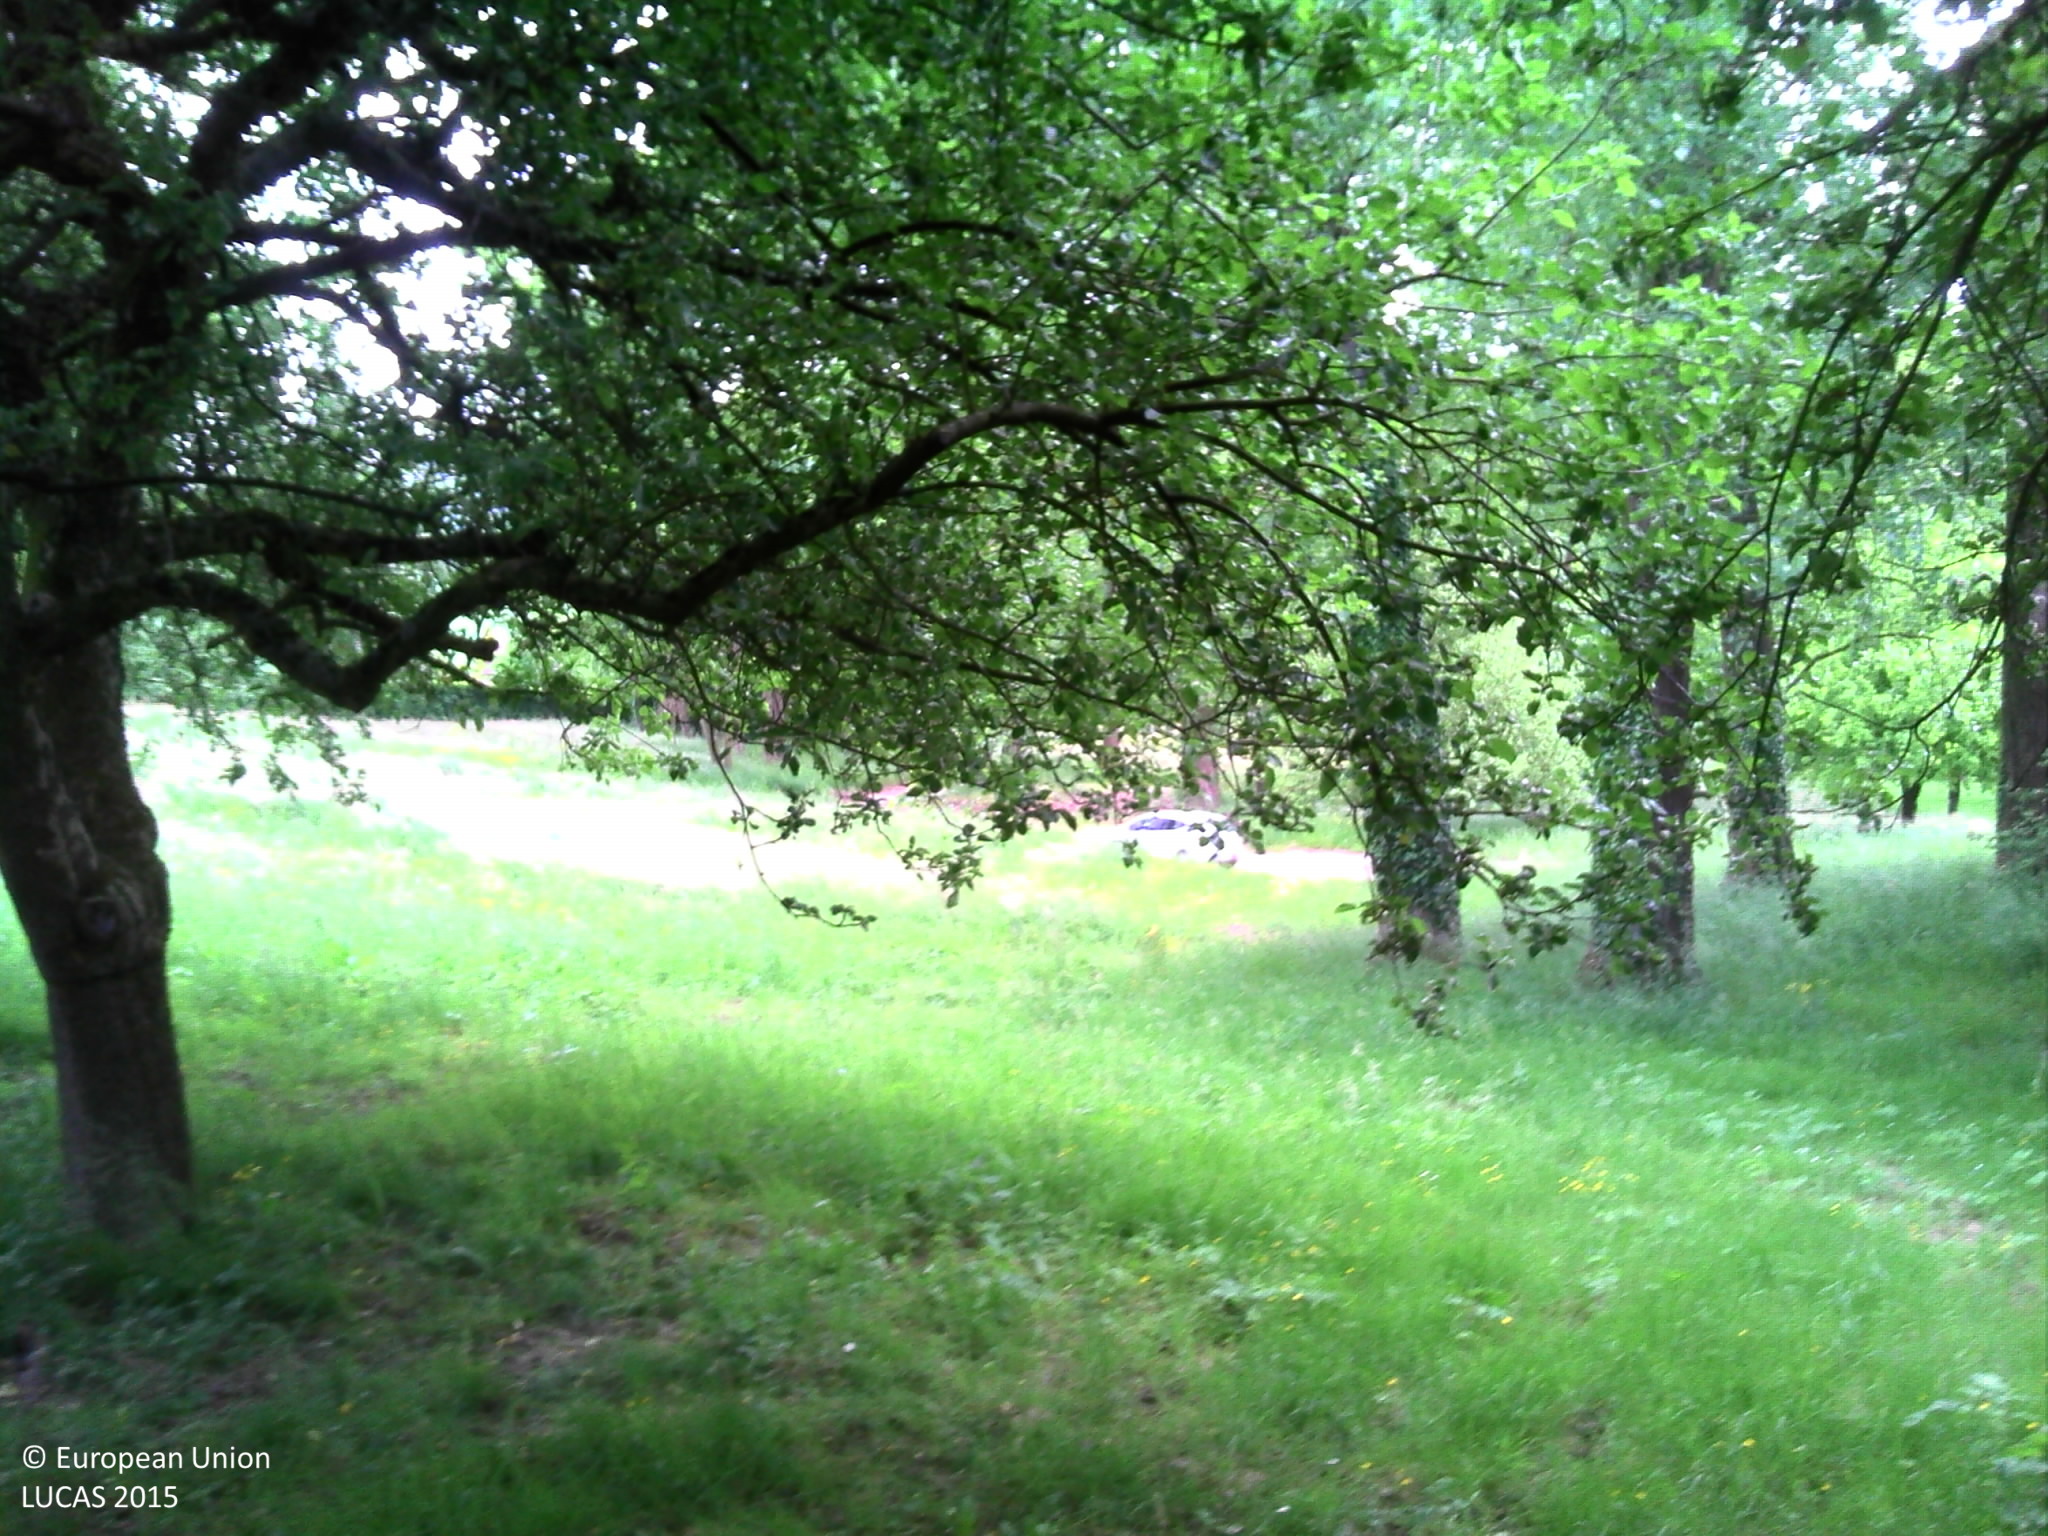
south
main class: Woodland
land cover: Broadleaved woodland
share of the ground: > 75 %
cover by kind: broadleaved forest trees 100 %
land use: Residential
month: May
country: BE
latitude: 50.7270
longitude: 4.6839
